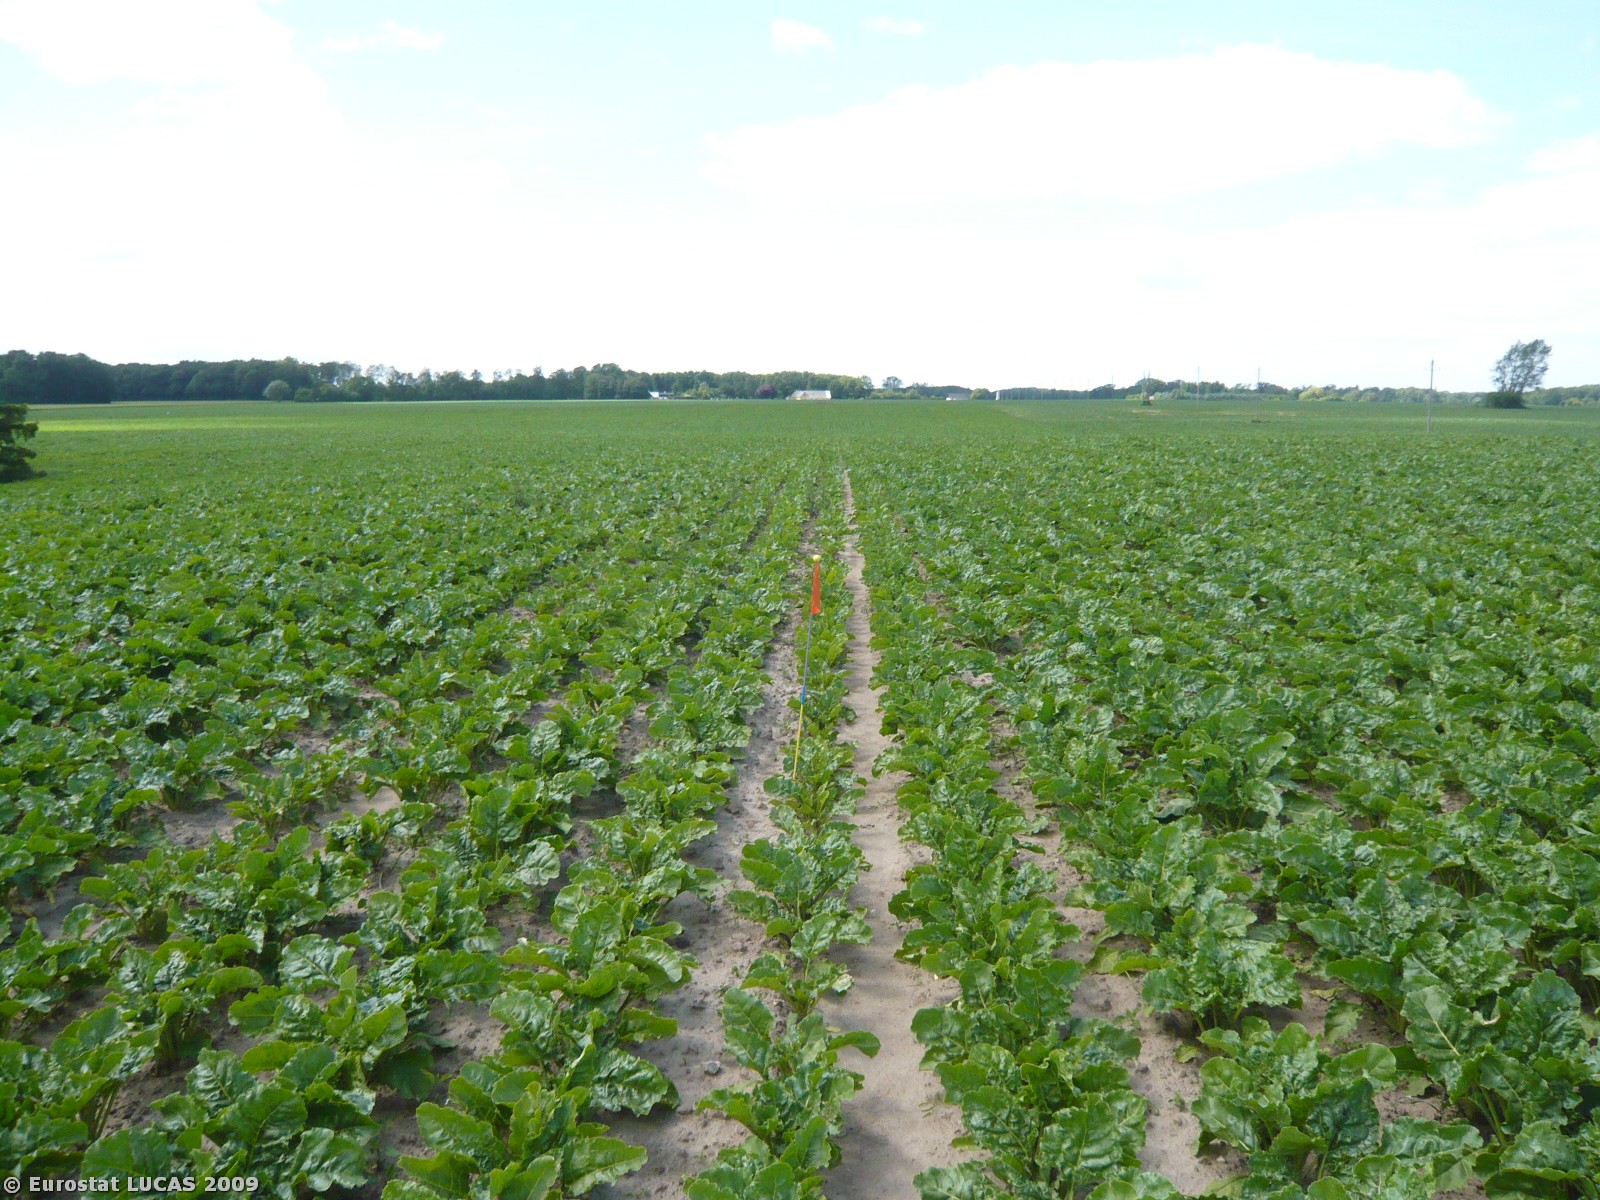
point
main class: Cropland
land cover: Sugar beet
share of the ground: > 75 %
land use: Agriculture (excluding fallow land and kitchen gardens)
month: June
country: DK
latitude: 54.8869
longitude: 11.2930
